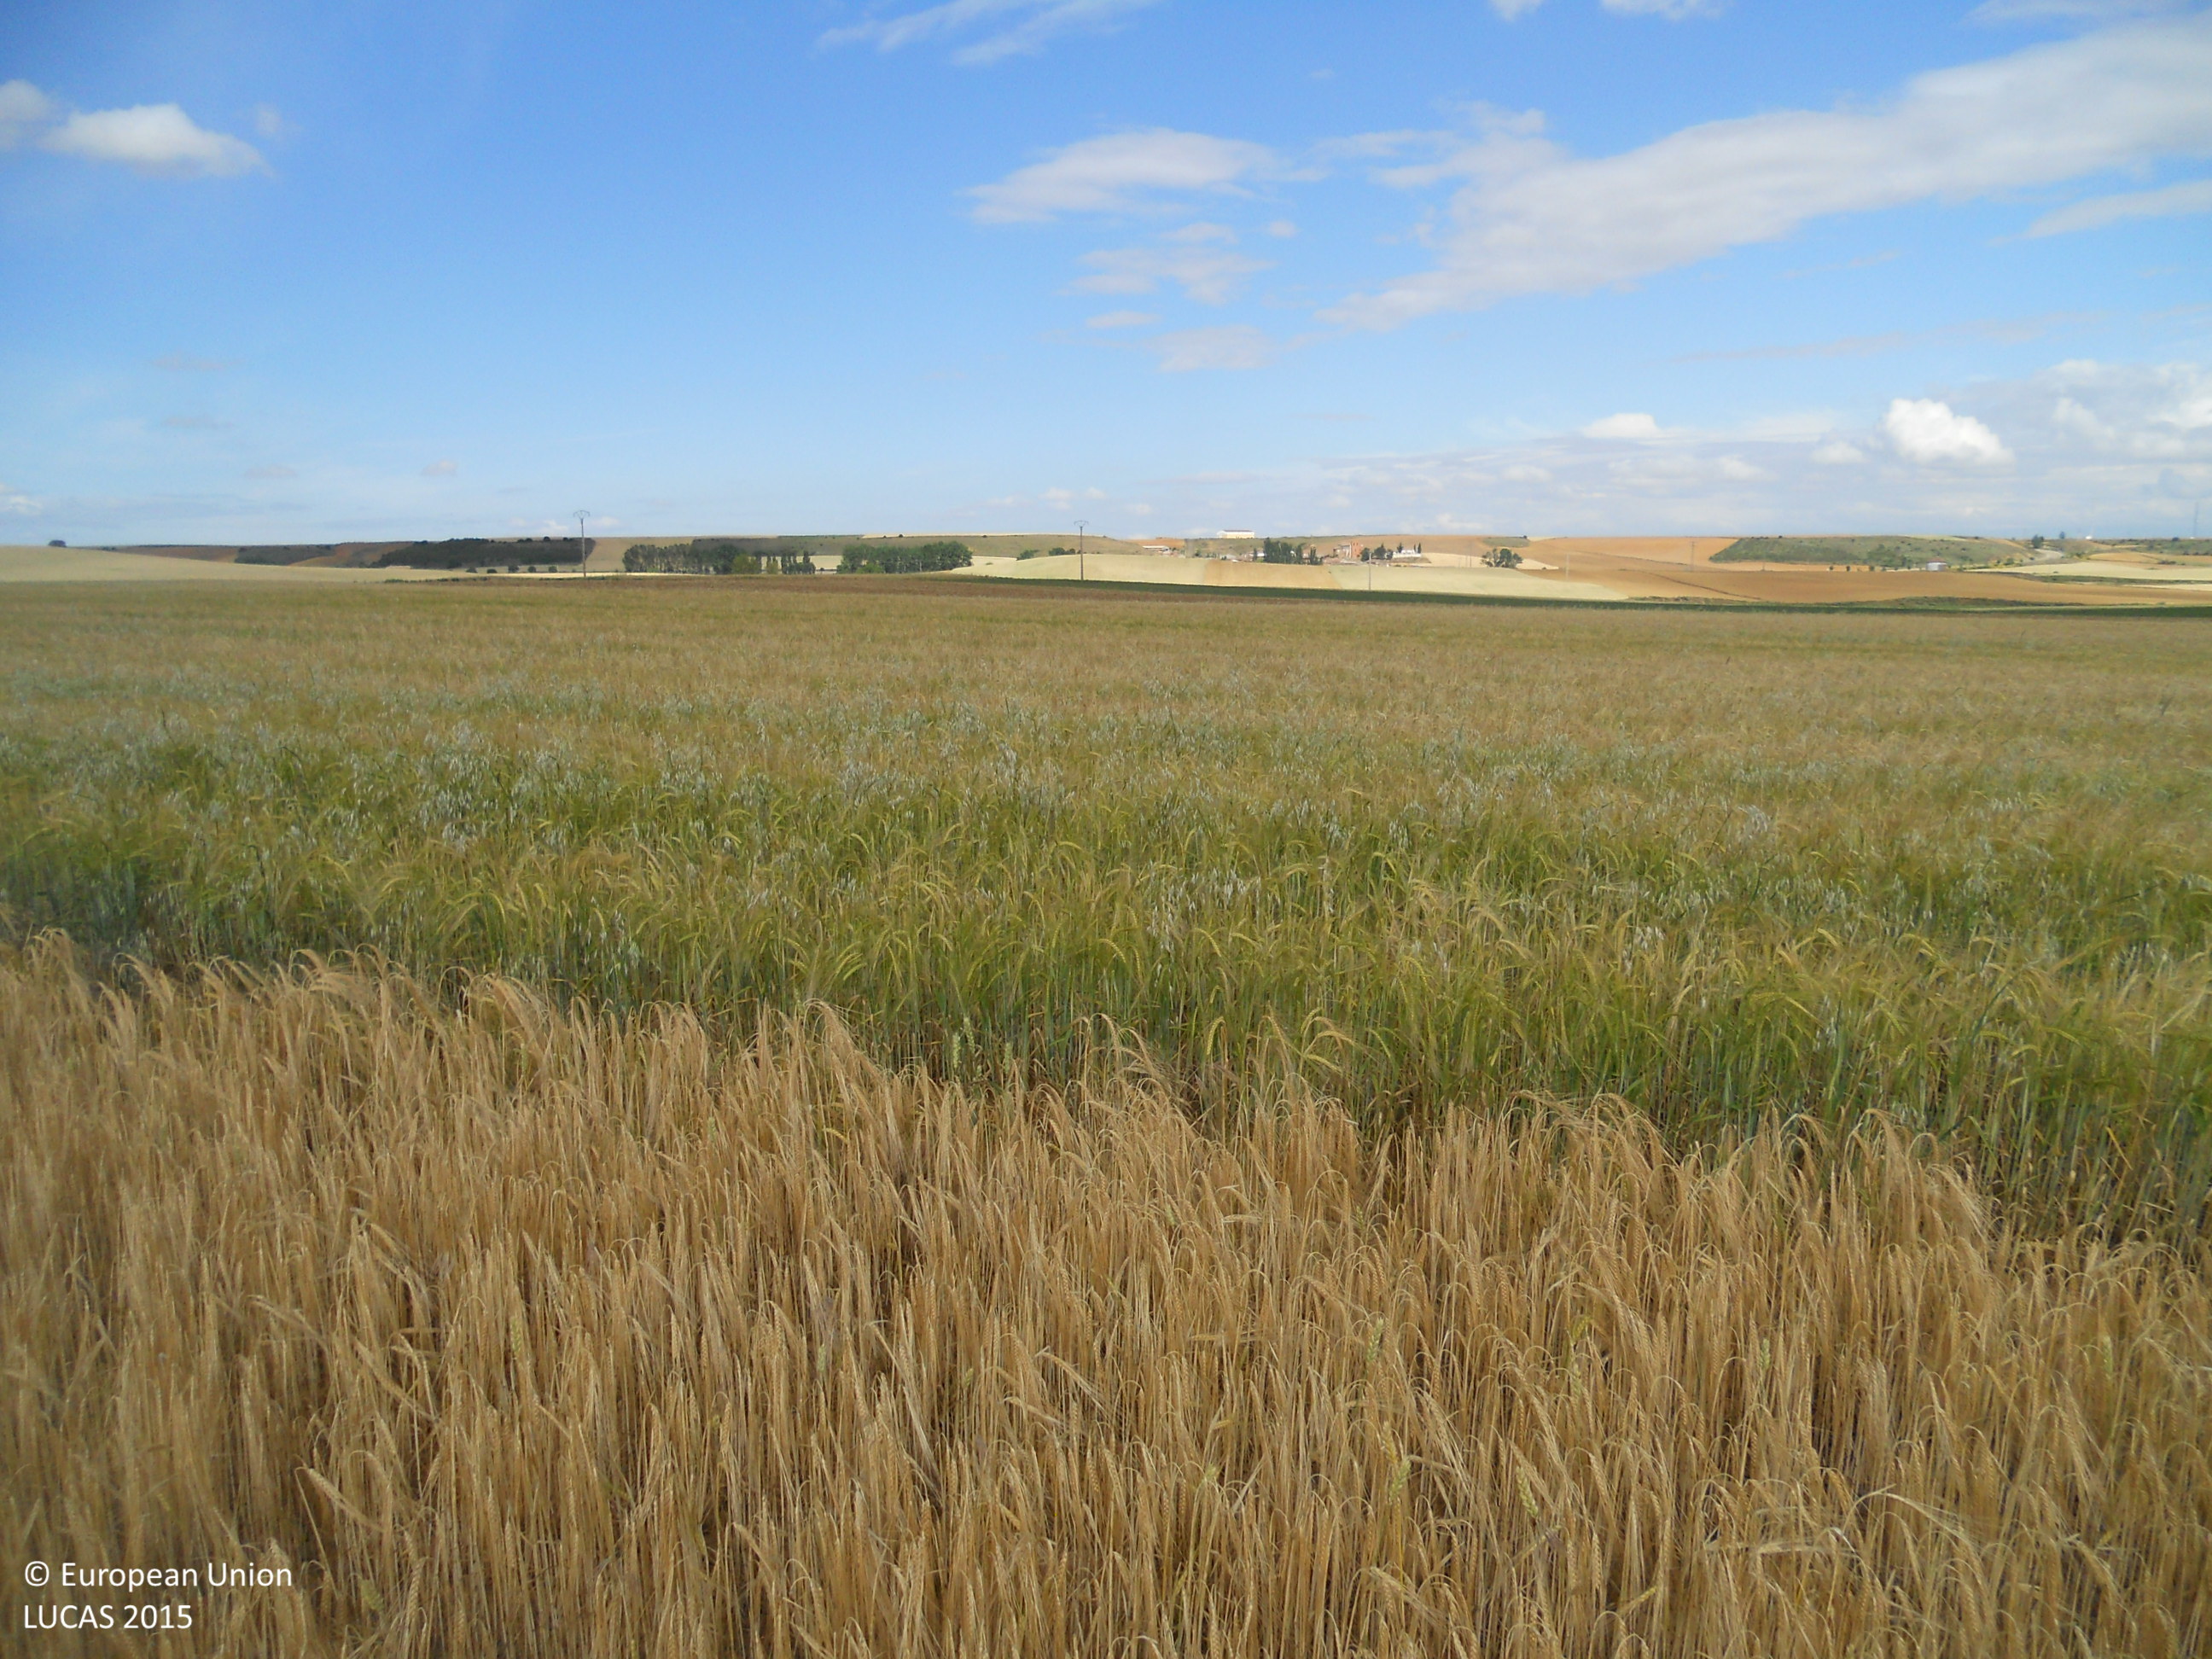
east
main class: Cropland
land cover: Barley
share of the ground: > 75 %
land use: Agriculture (excluding fallow land and kitchen gardens)
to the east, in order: Barley; Grass margins; Barley; Grass margins; Other bare soil; Lucerne
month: June
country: ES
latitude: 42.3545
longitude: -4.8797
